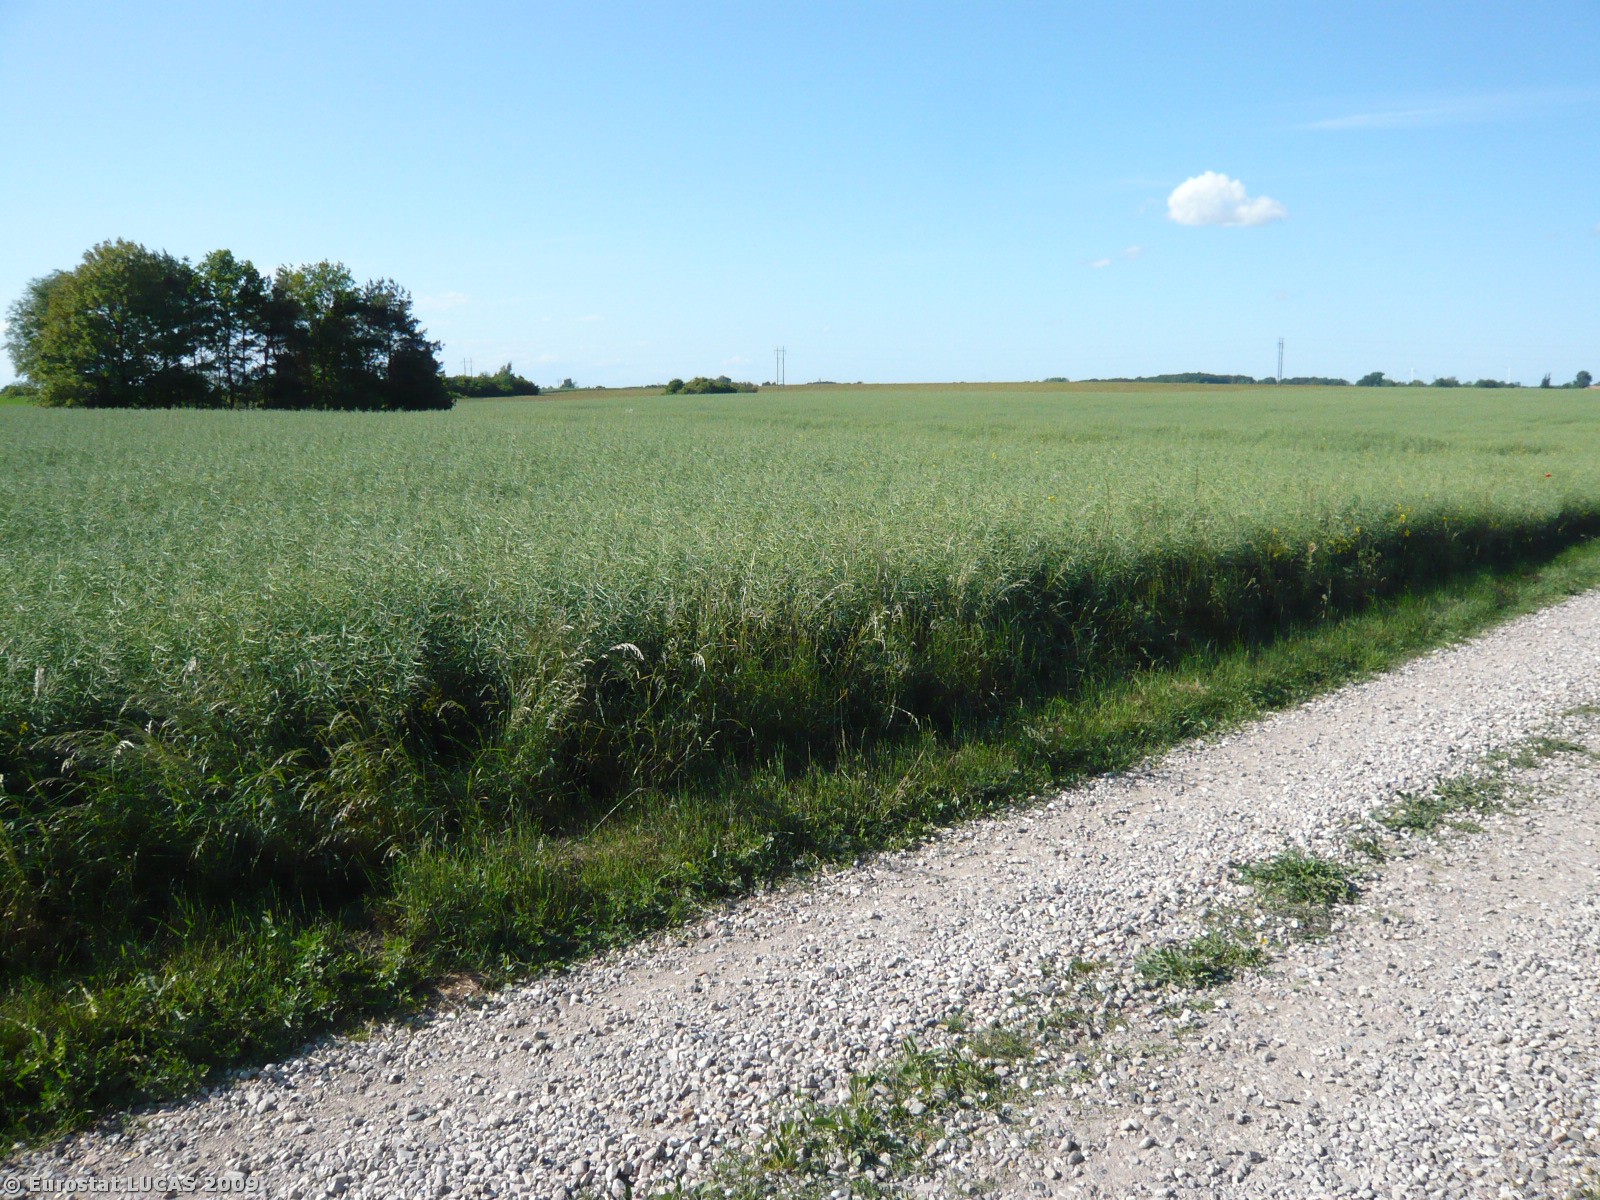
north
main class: Cropland
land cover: Rape and turnip rape
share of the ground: > 75 %
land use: Agriculture (excluding fallow land and kitchen gardens)
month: June
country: DK
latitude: 55.3191
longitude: 11.2124
